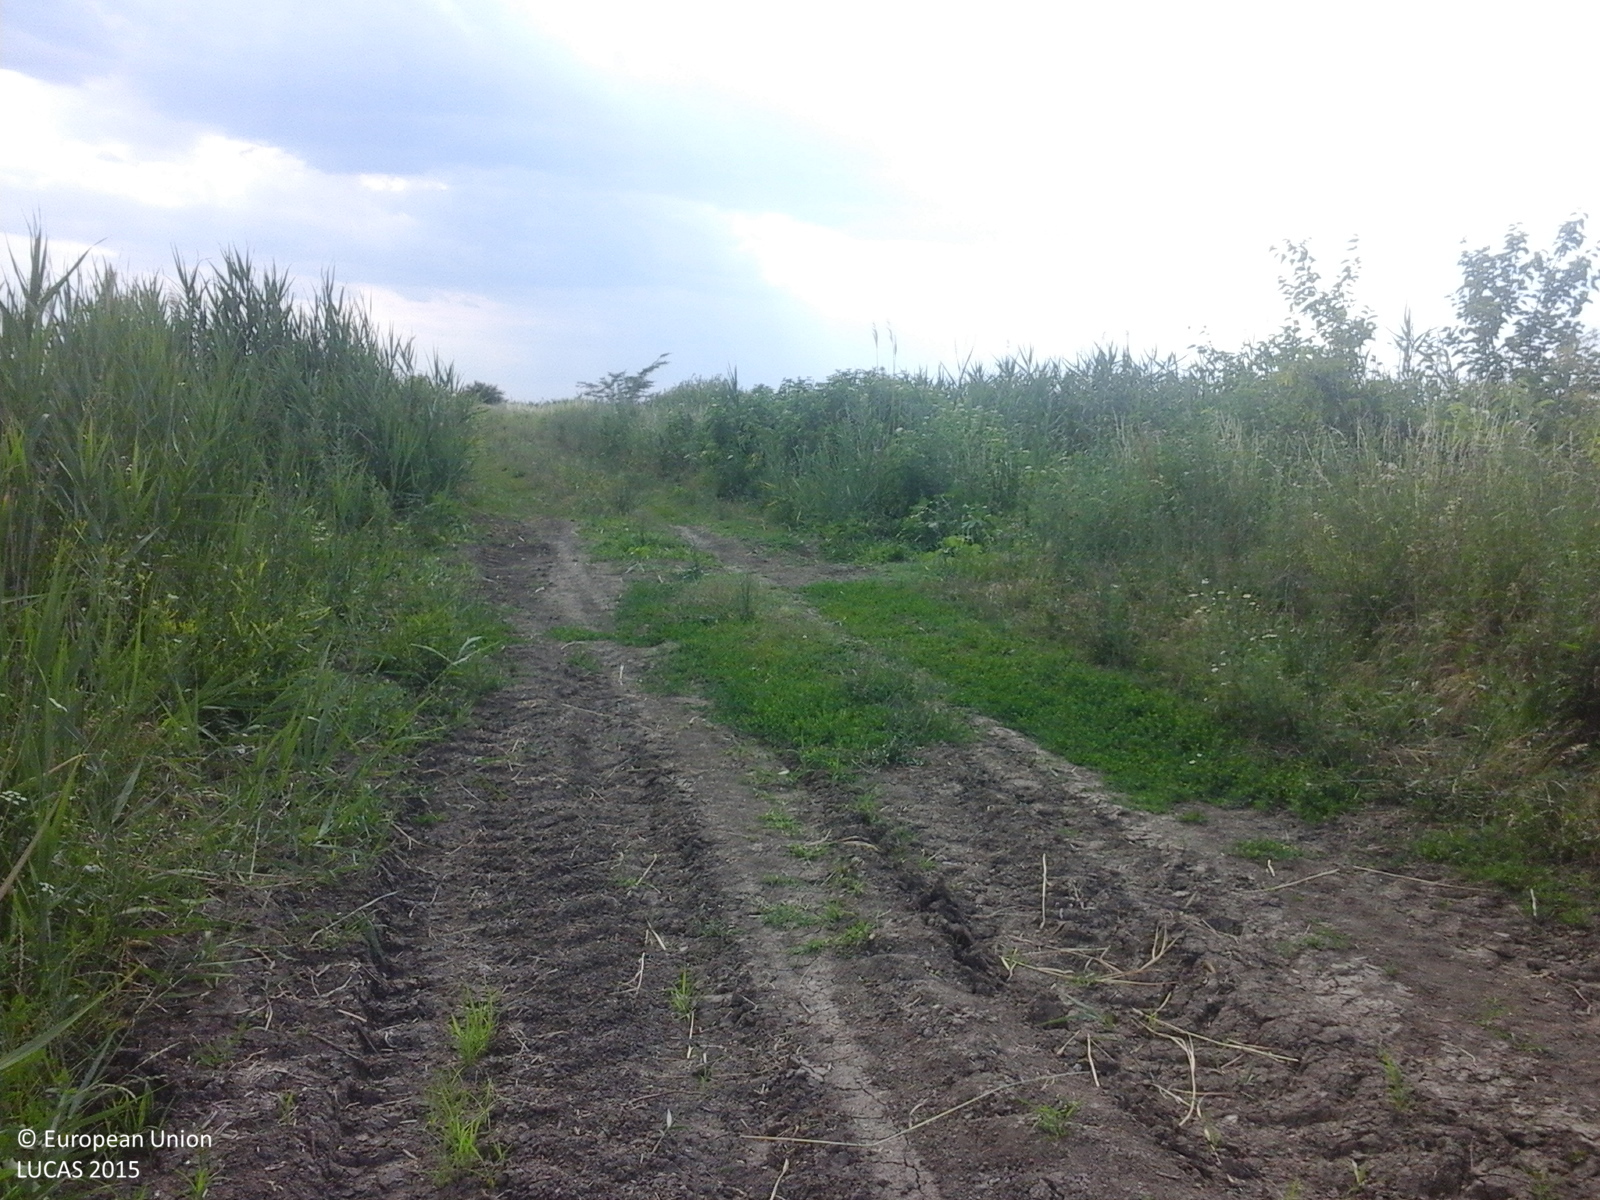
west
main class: Grassland
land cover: Spontaneously vegetated surfaces
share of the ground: > 75 %
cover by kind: herbaceous plants 100 %
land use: Semi-natural and natural areas not in use
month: June
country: RO
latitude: 44.0968
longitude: 26.5383
